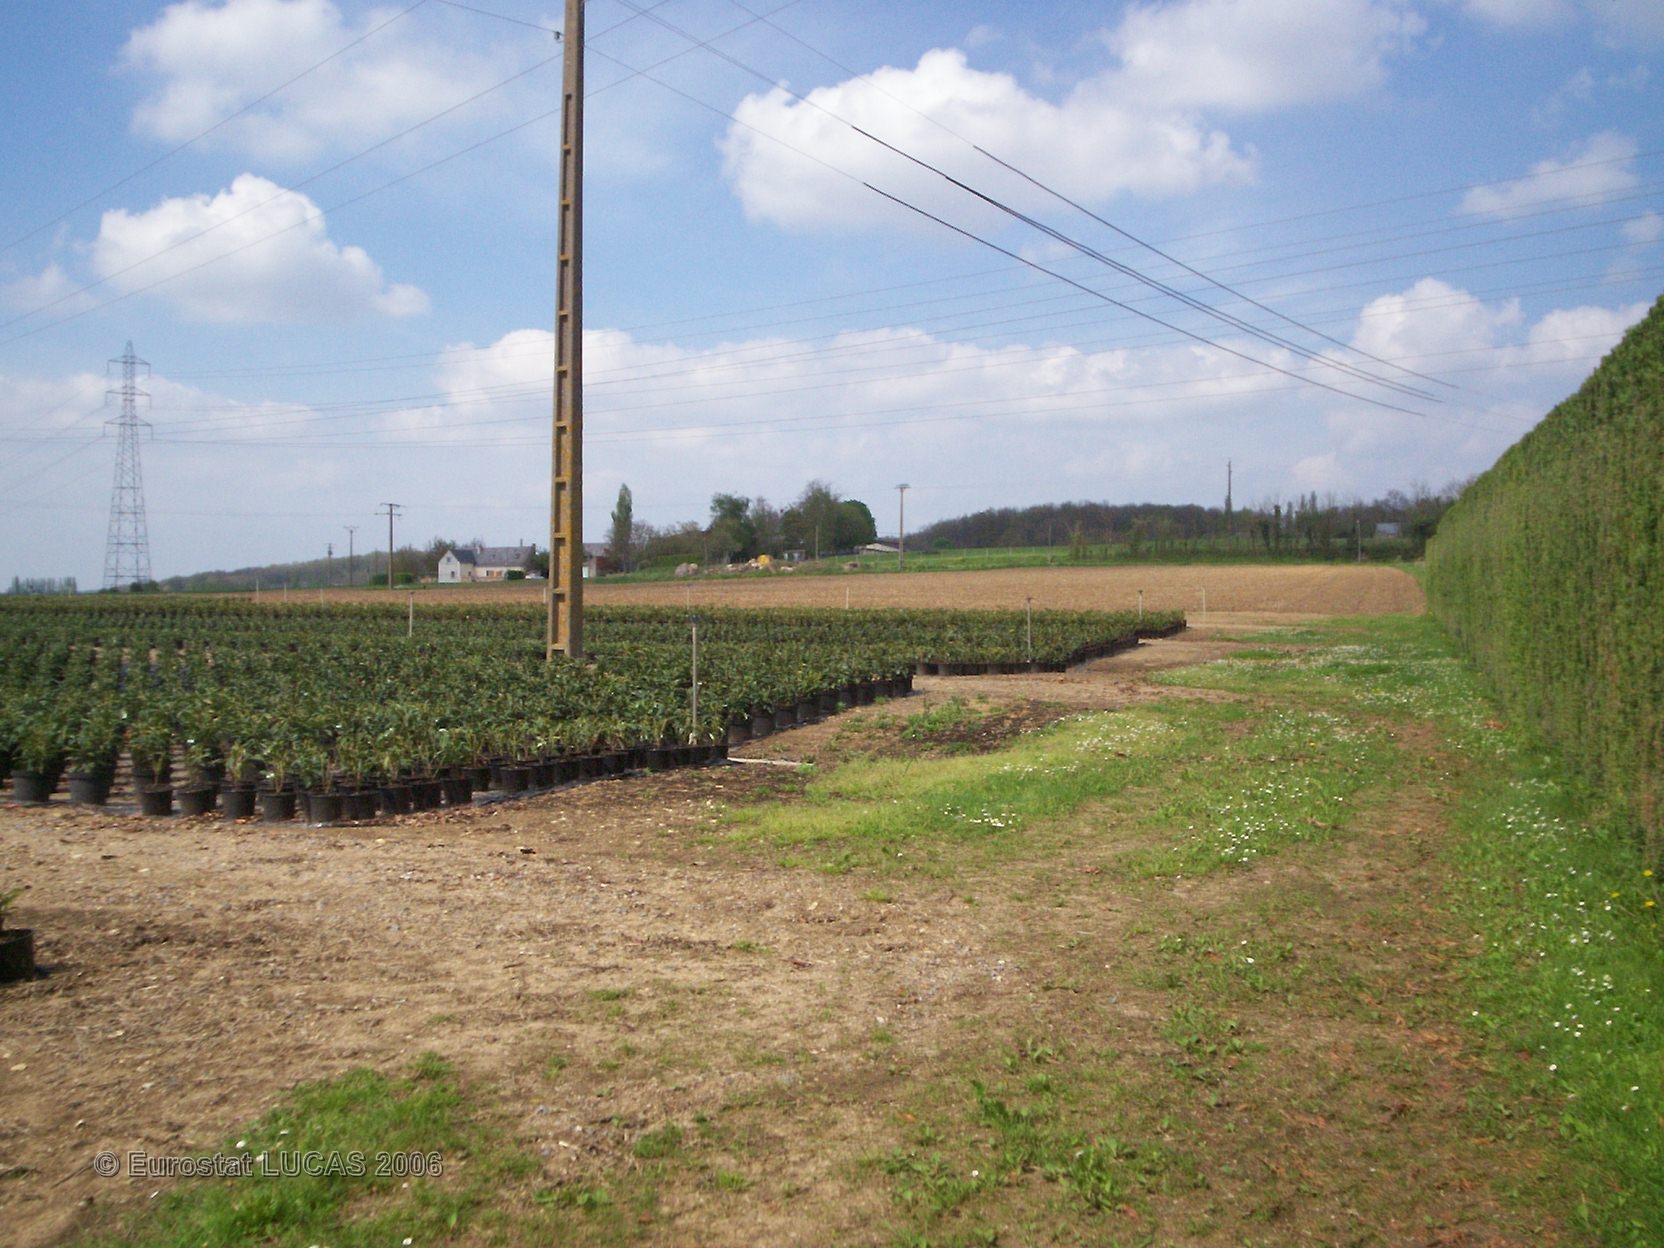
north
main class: Grassland
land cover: Grassland without tree/shrub cover
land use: Agriculture (excluding fallow land and kitchen gardens)
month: April
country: FR
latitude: 47.3498
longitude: -0.3943
